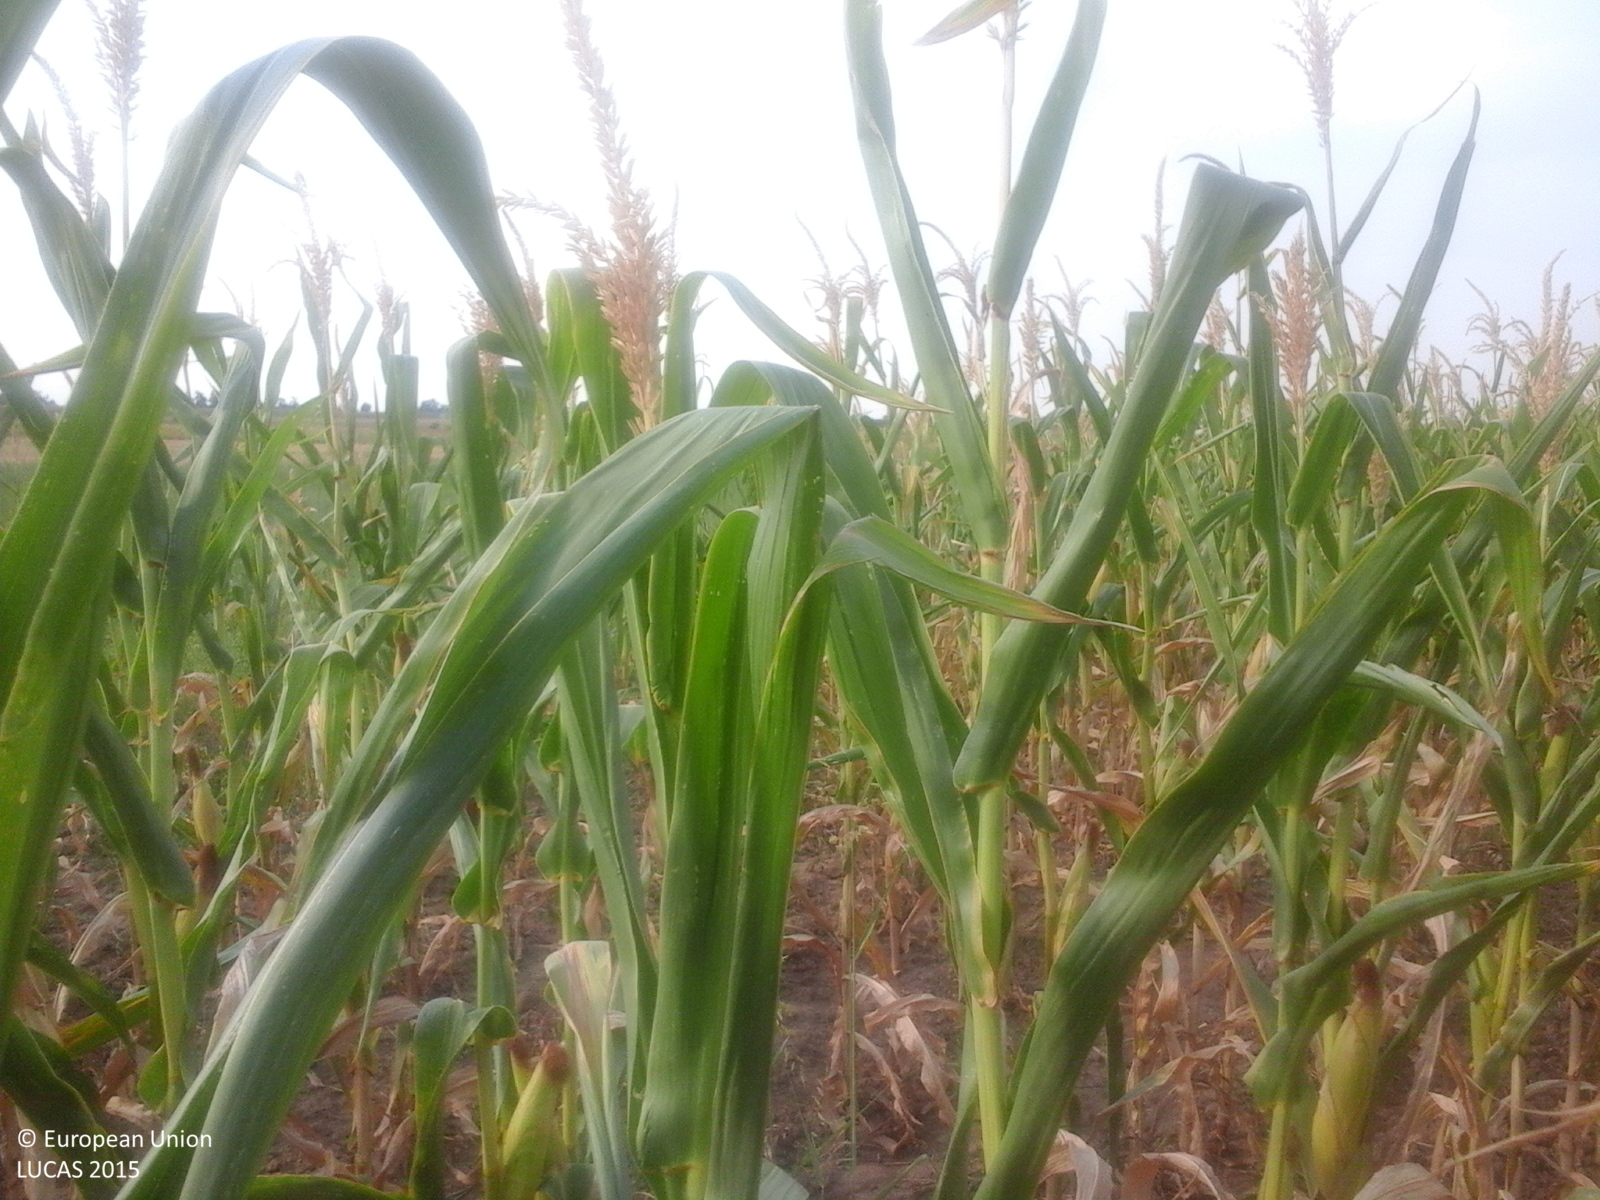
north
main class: Cropland
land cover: Maize
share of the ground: > 75 %
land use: Agriculture (excluding fallow land and kitchen gardens)
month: August
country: RO
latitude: 44.2417
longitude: 22.6987
